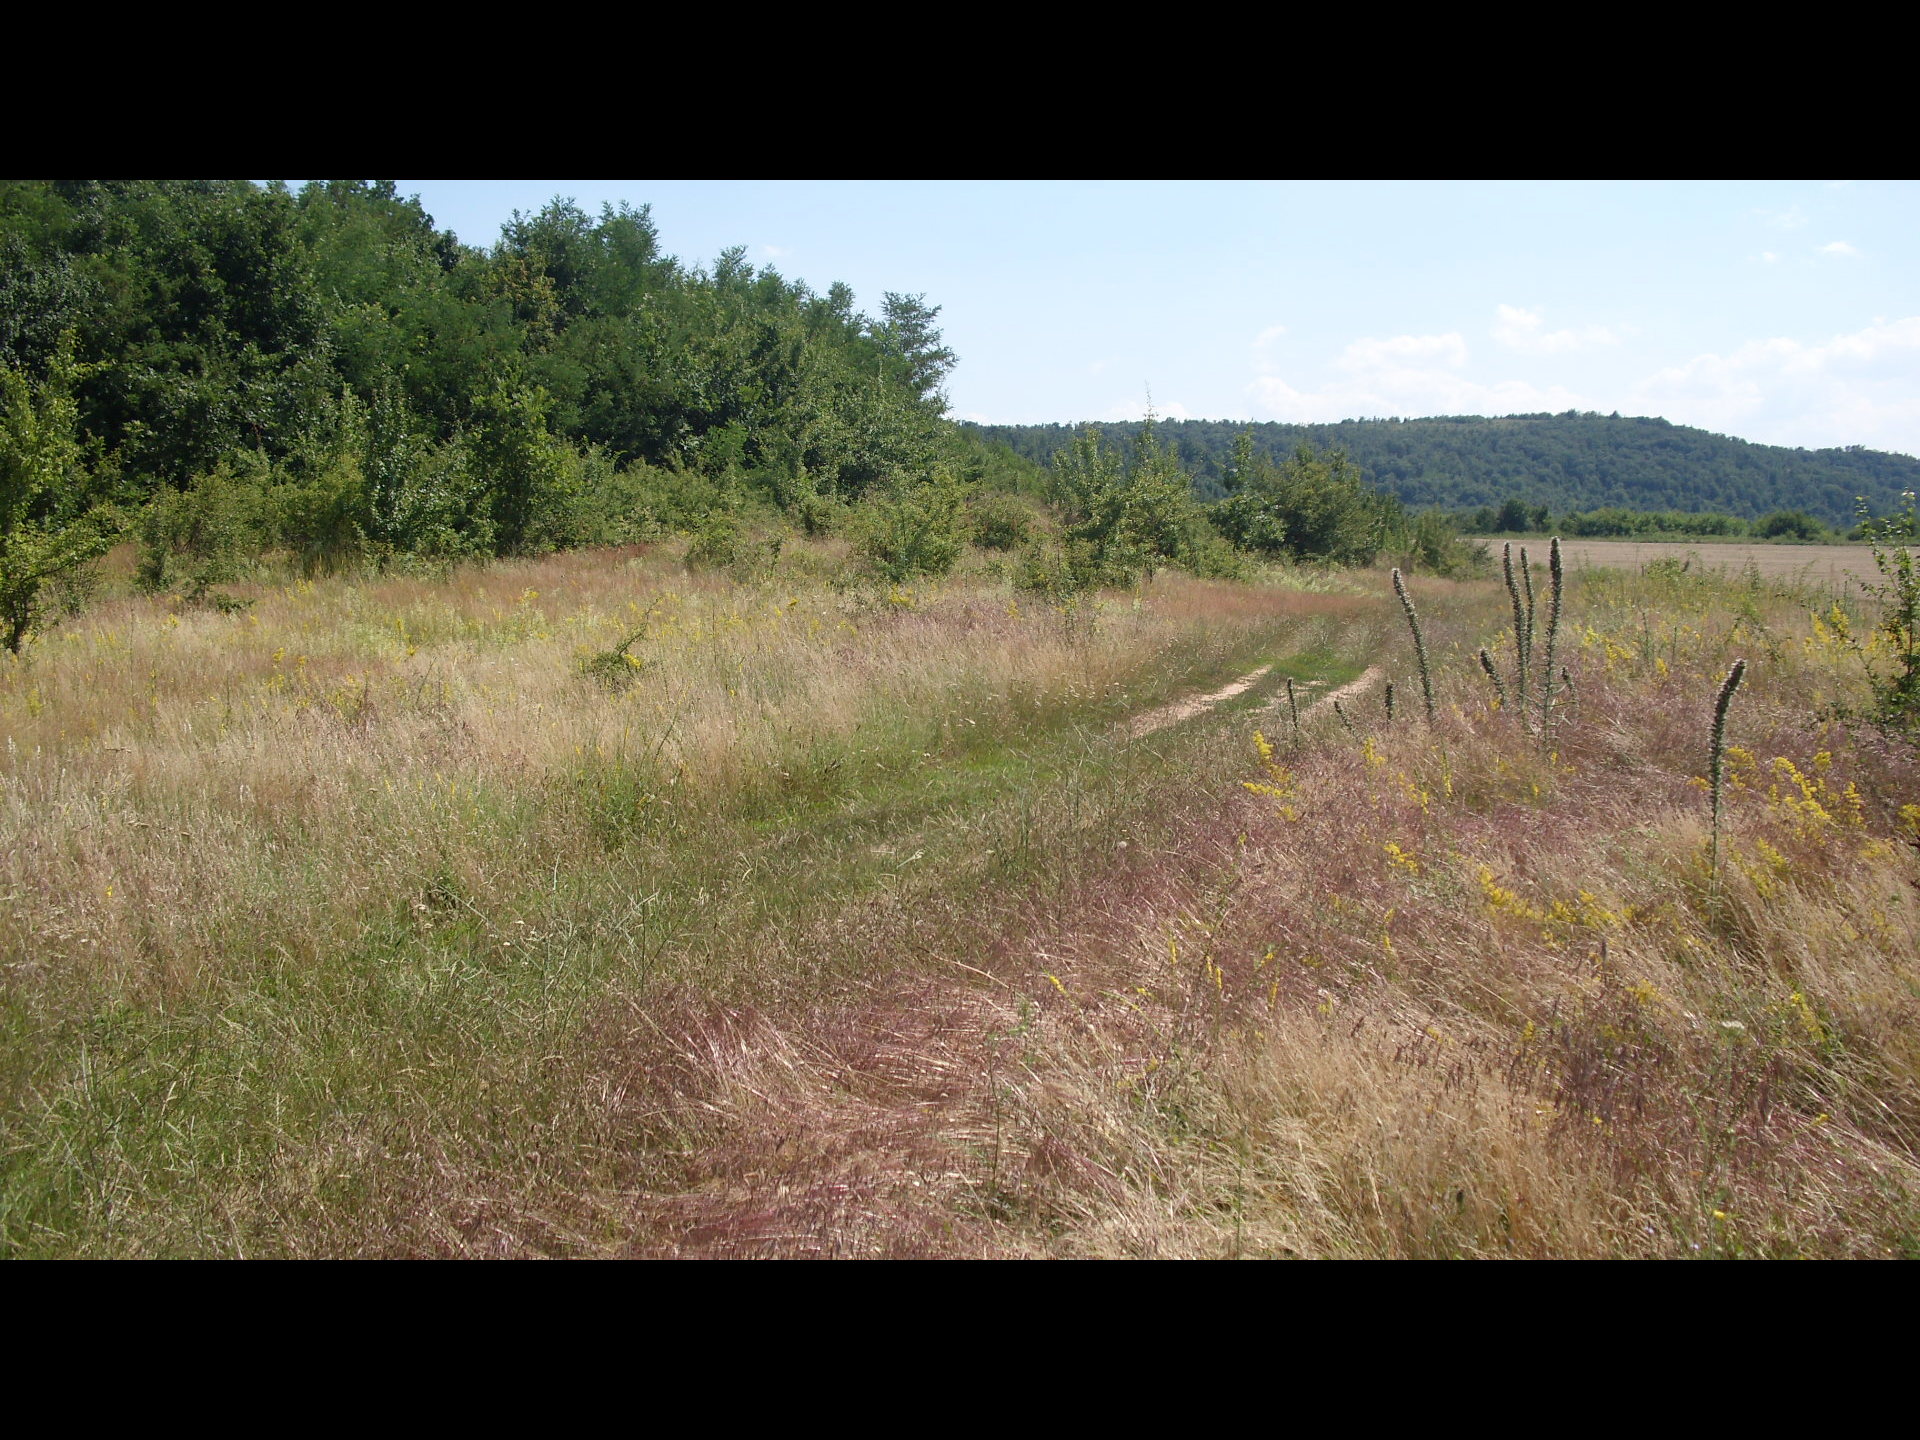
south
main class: Grassland
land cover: Spontaneously vegetated surfaces
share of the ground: > 75 %
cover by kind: herbaceous plants 100 %
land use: Agriculture (excluding fallow land and kitchen gardens)
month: July
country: BG
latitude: 43.6801
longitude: 23.1021
